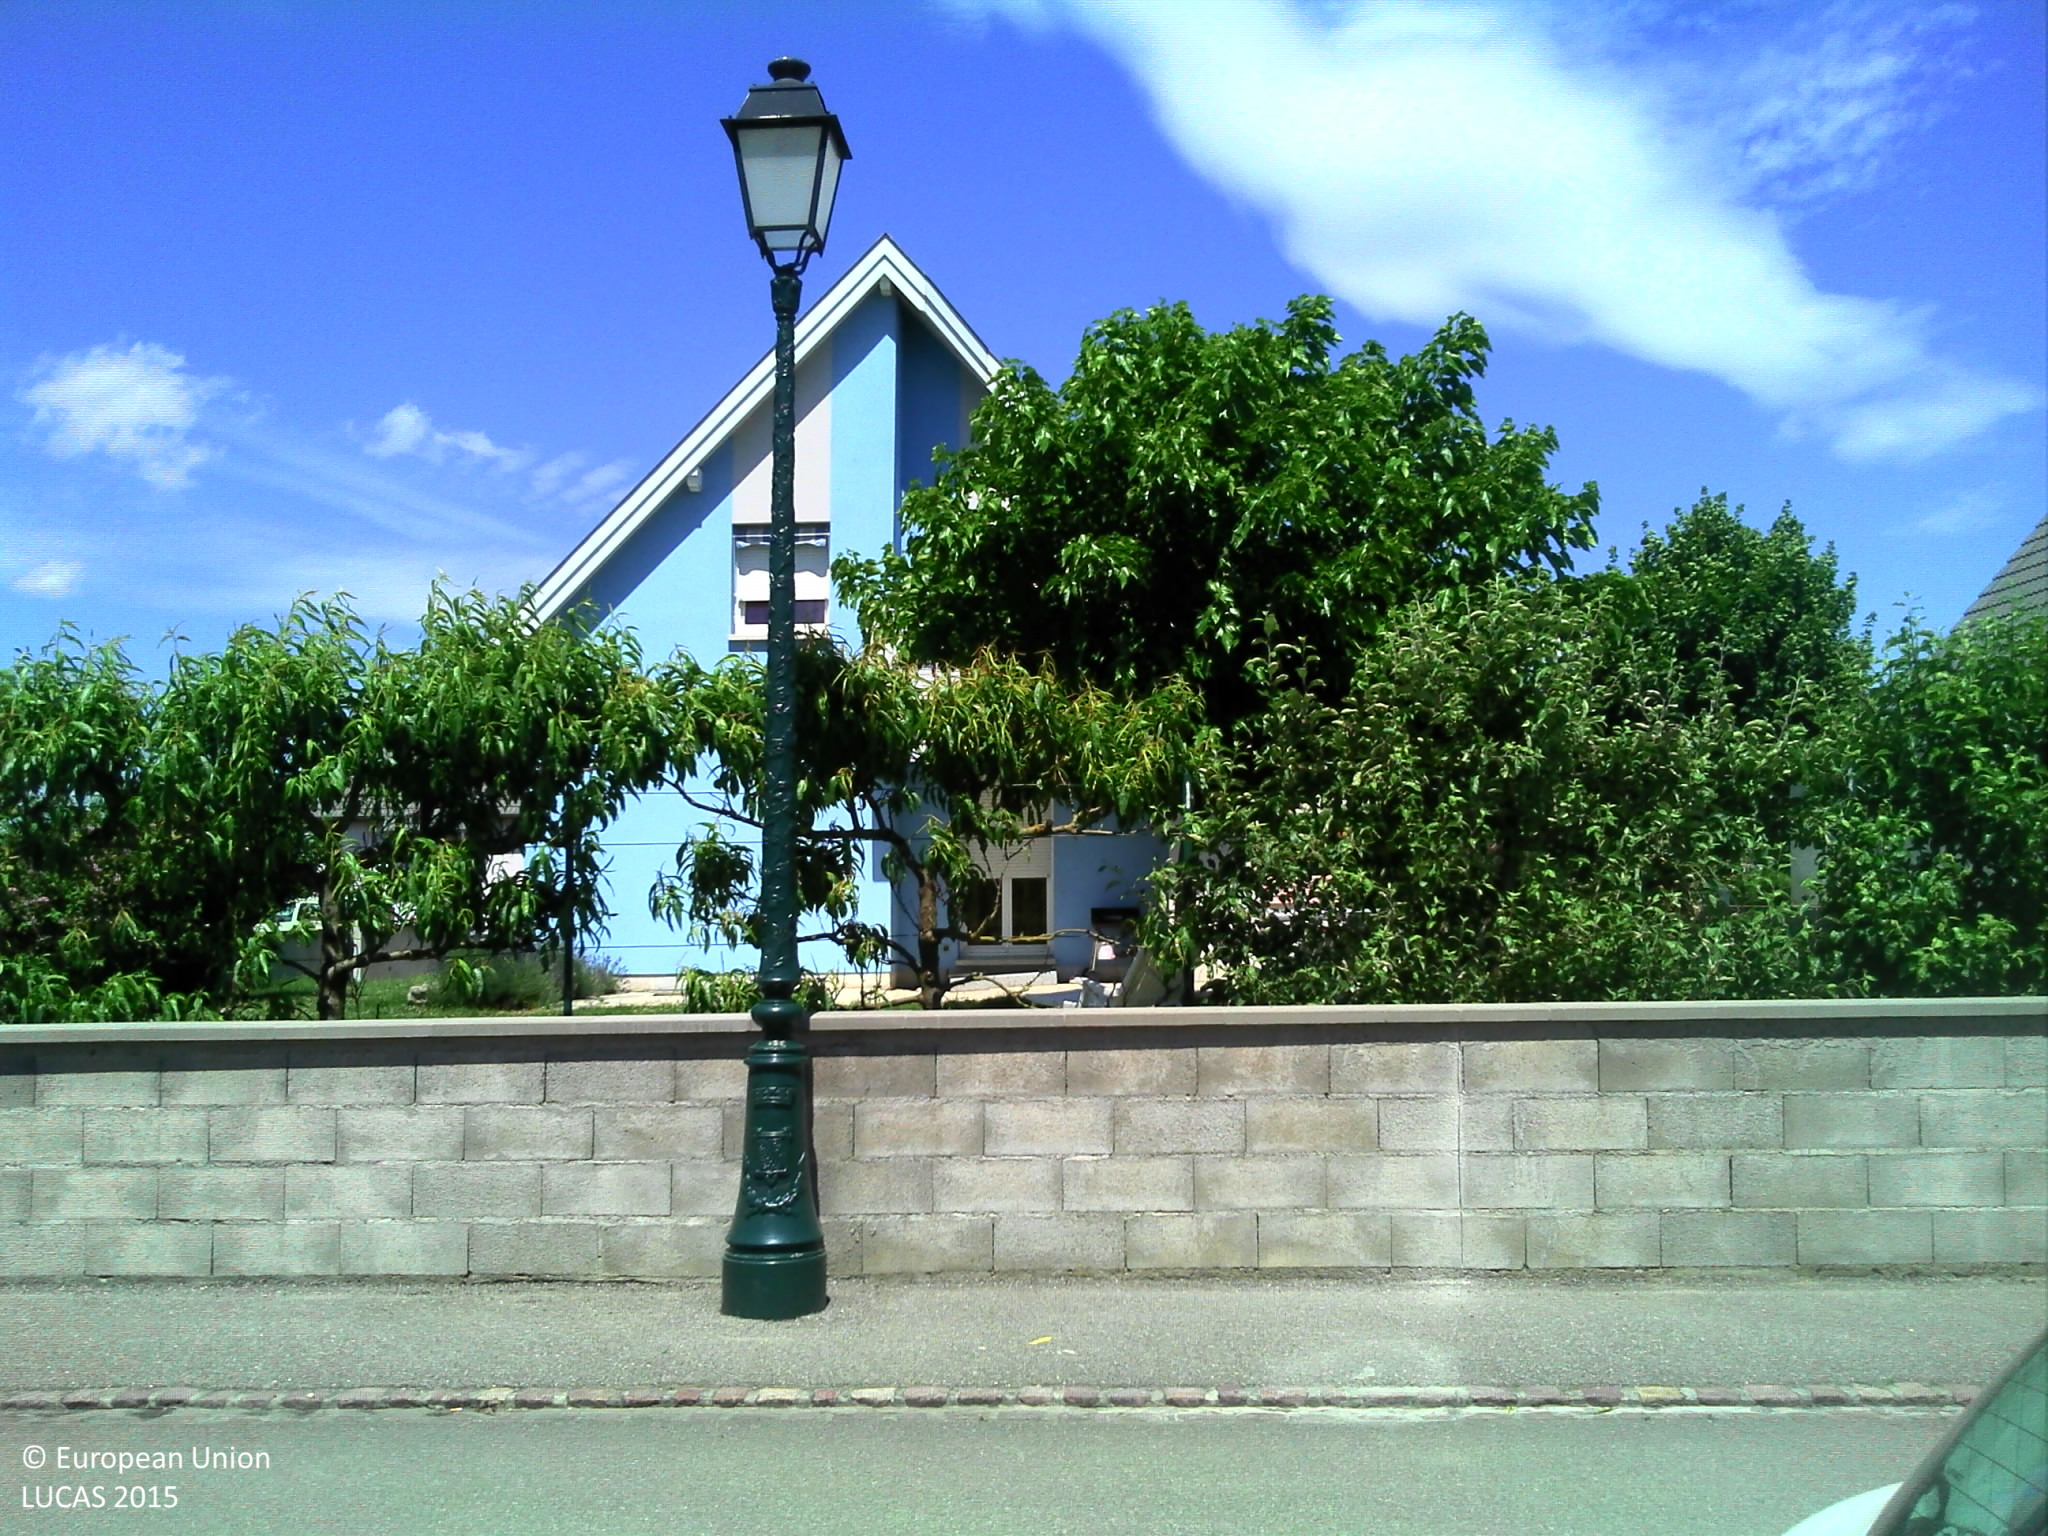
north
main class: Grassland
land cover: Grassland with sparse tree/shrub cover
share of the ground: > 75 %
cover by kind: herbaceous plants 95 %, broadleaved forest trees 5 %
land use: Residential
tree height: < 5 m
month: June
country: FR
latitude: 47.9586
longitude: 7.3898
